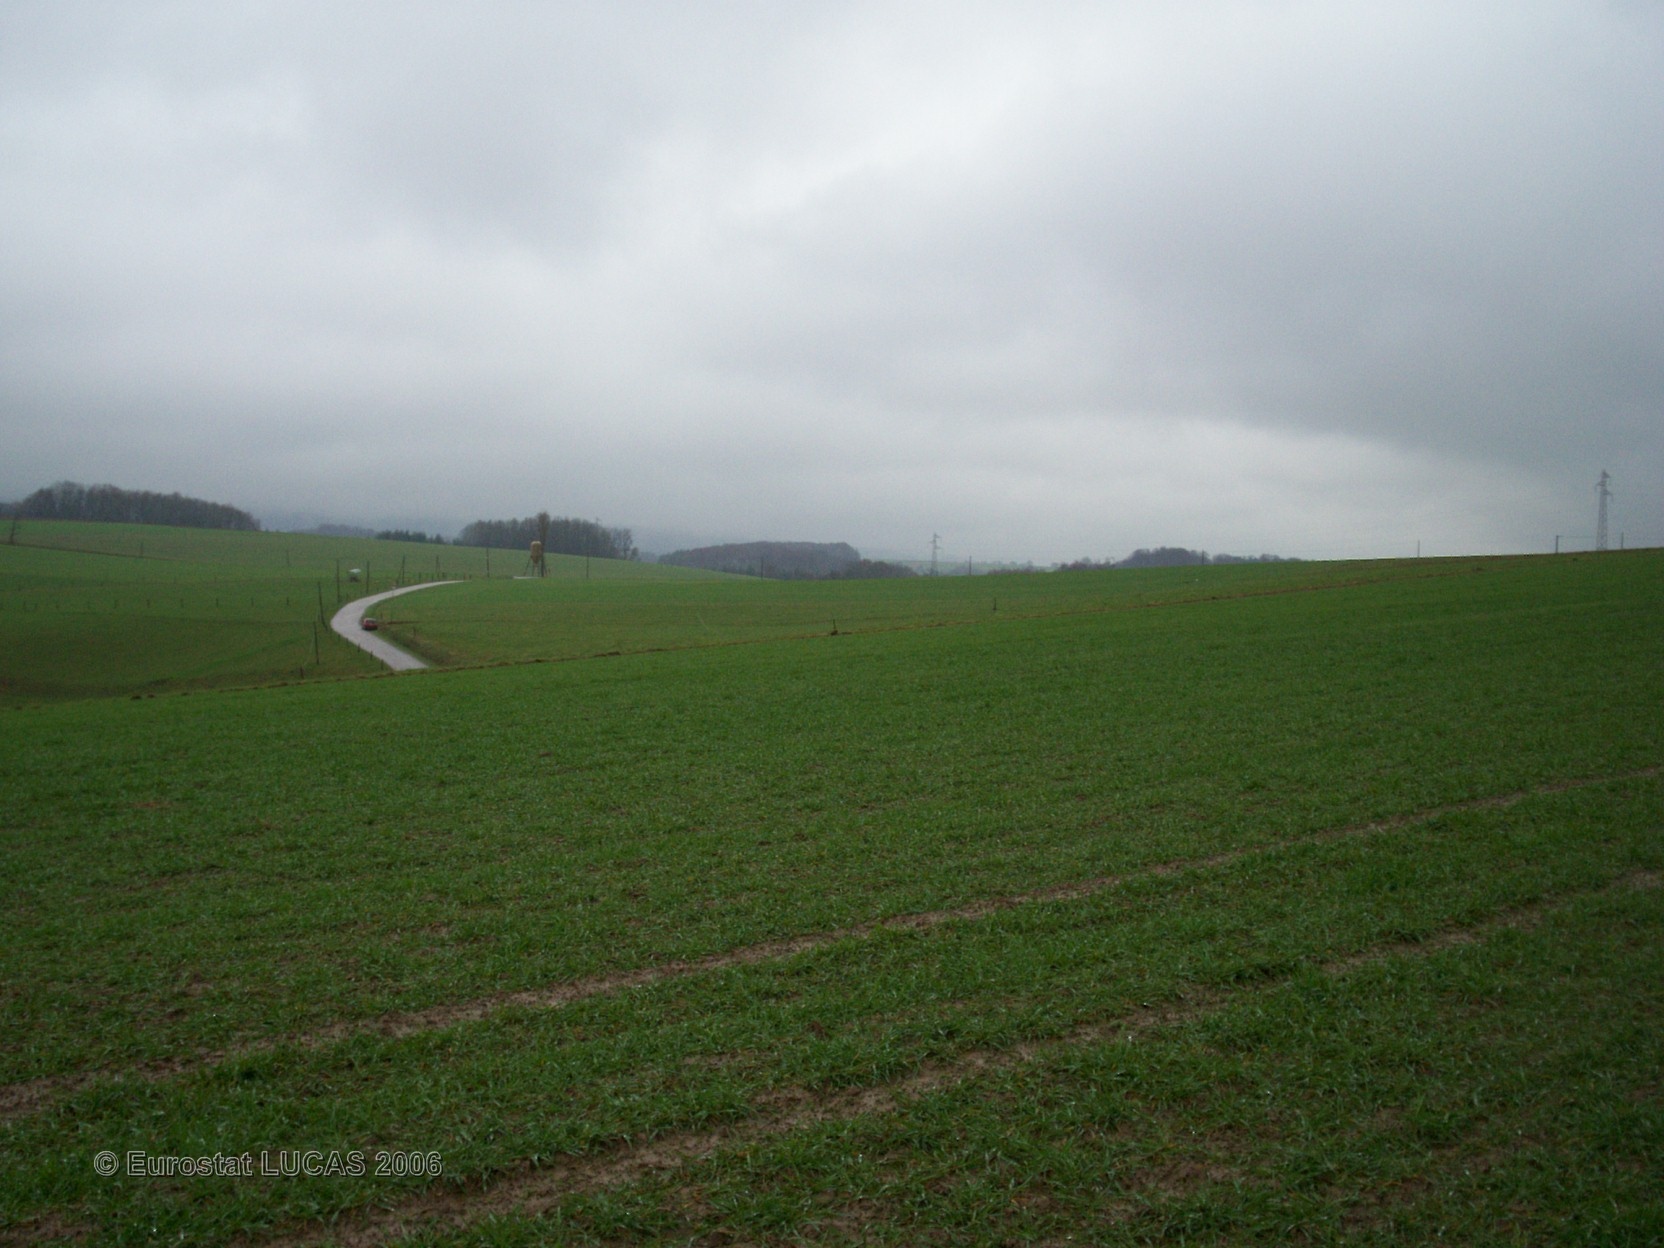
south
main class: Cropland
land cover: Common wheat
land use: Agriculture (excluding fallow land and kitchen gardens)
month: April
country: FR
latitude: 48.0726
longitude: 6.3367
